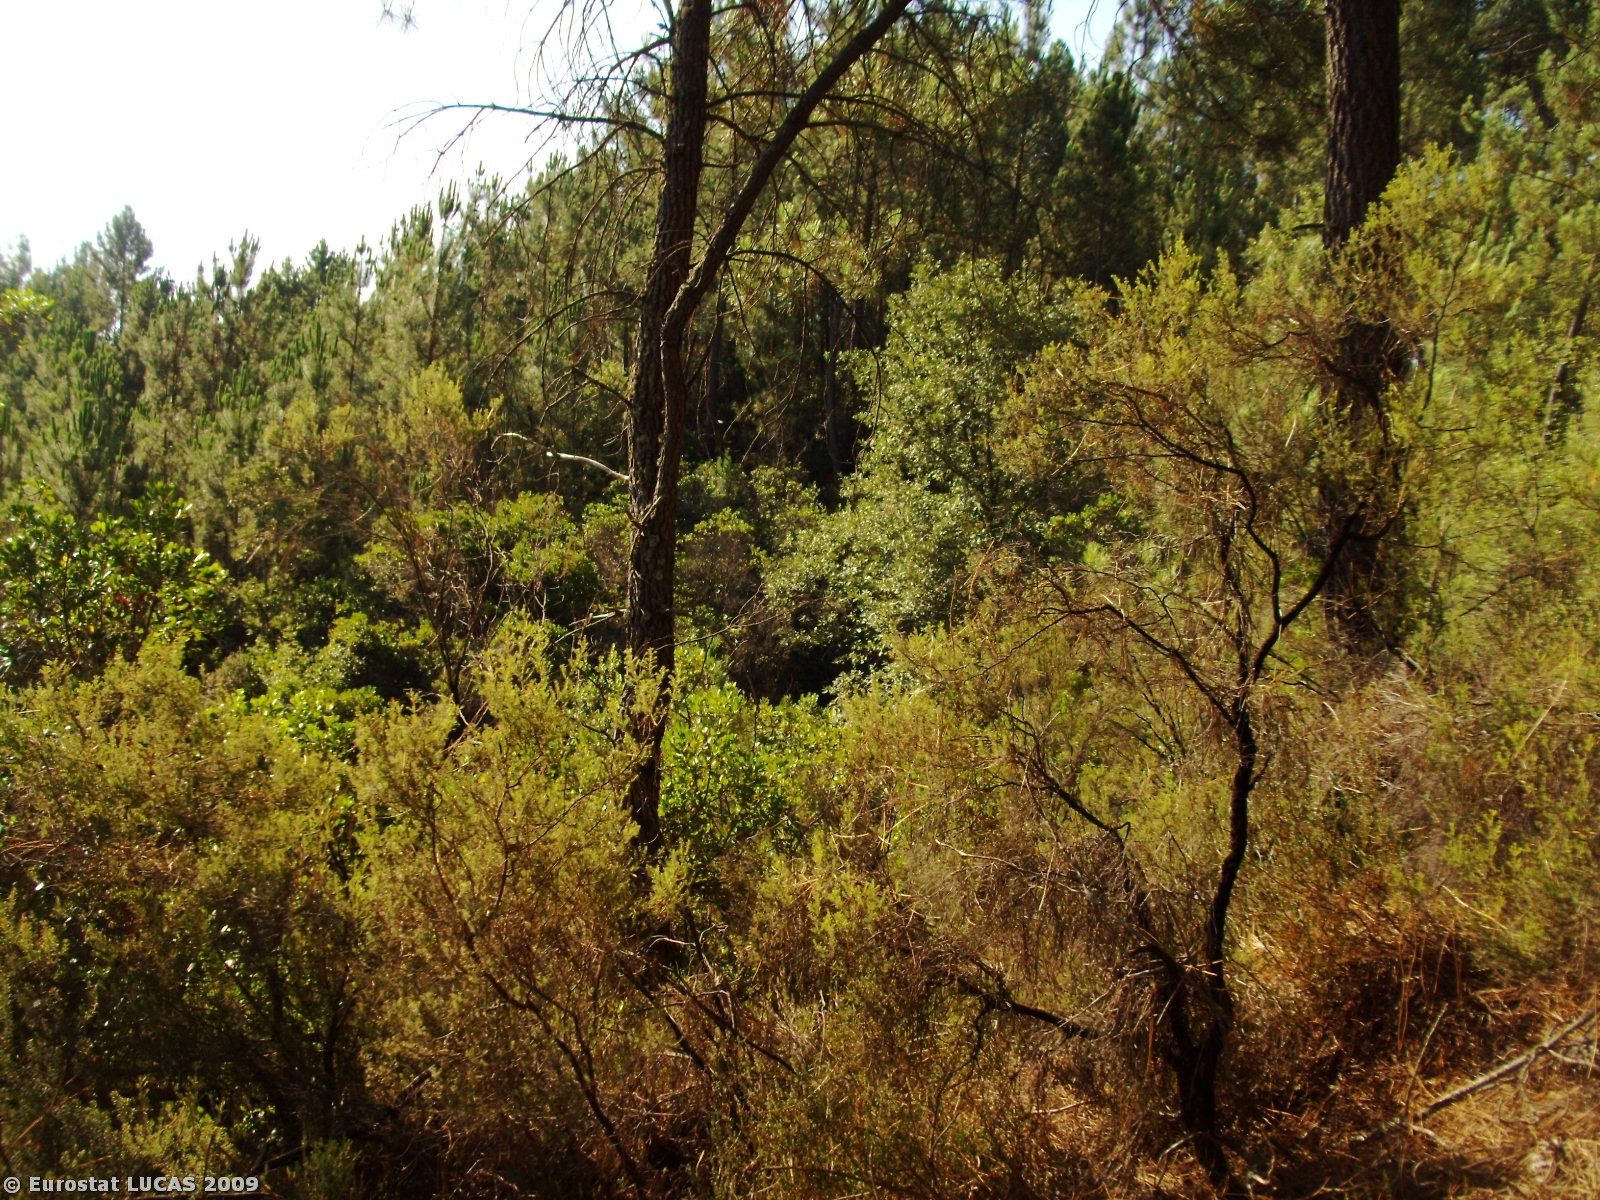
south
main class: Woodland
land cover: Coniferous woodland
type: coniferous forest of the mediterranean region
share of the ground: > 75 %
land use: Forestry
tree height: > 5 m
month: August
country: PT
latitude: 39.8039
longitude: -8.1132
